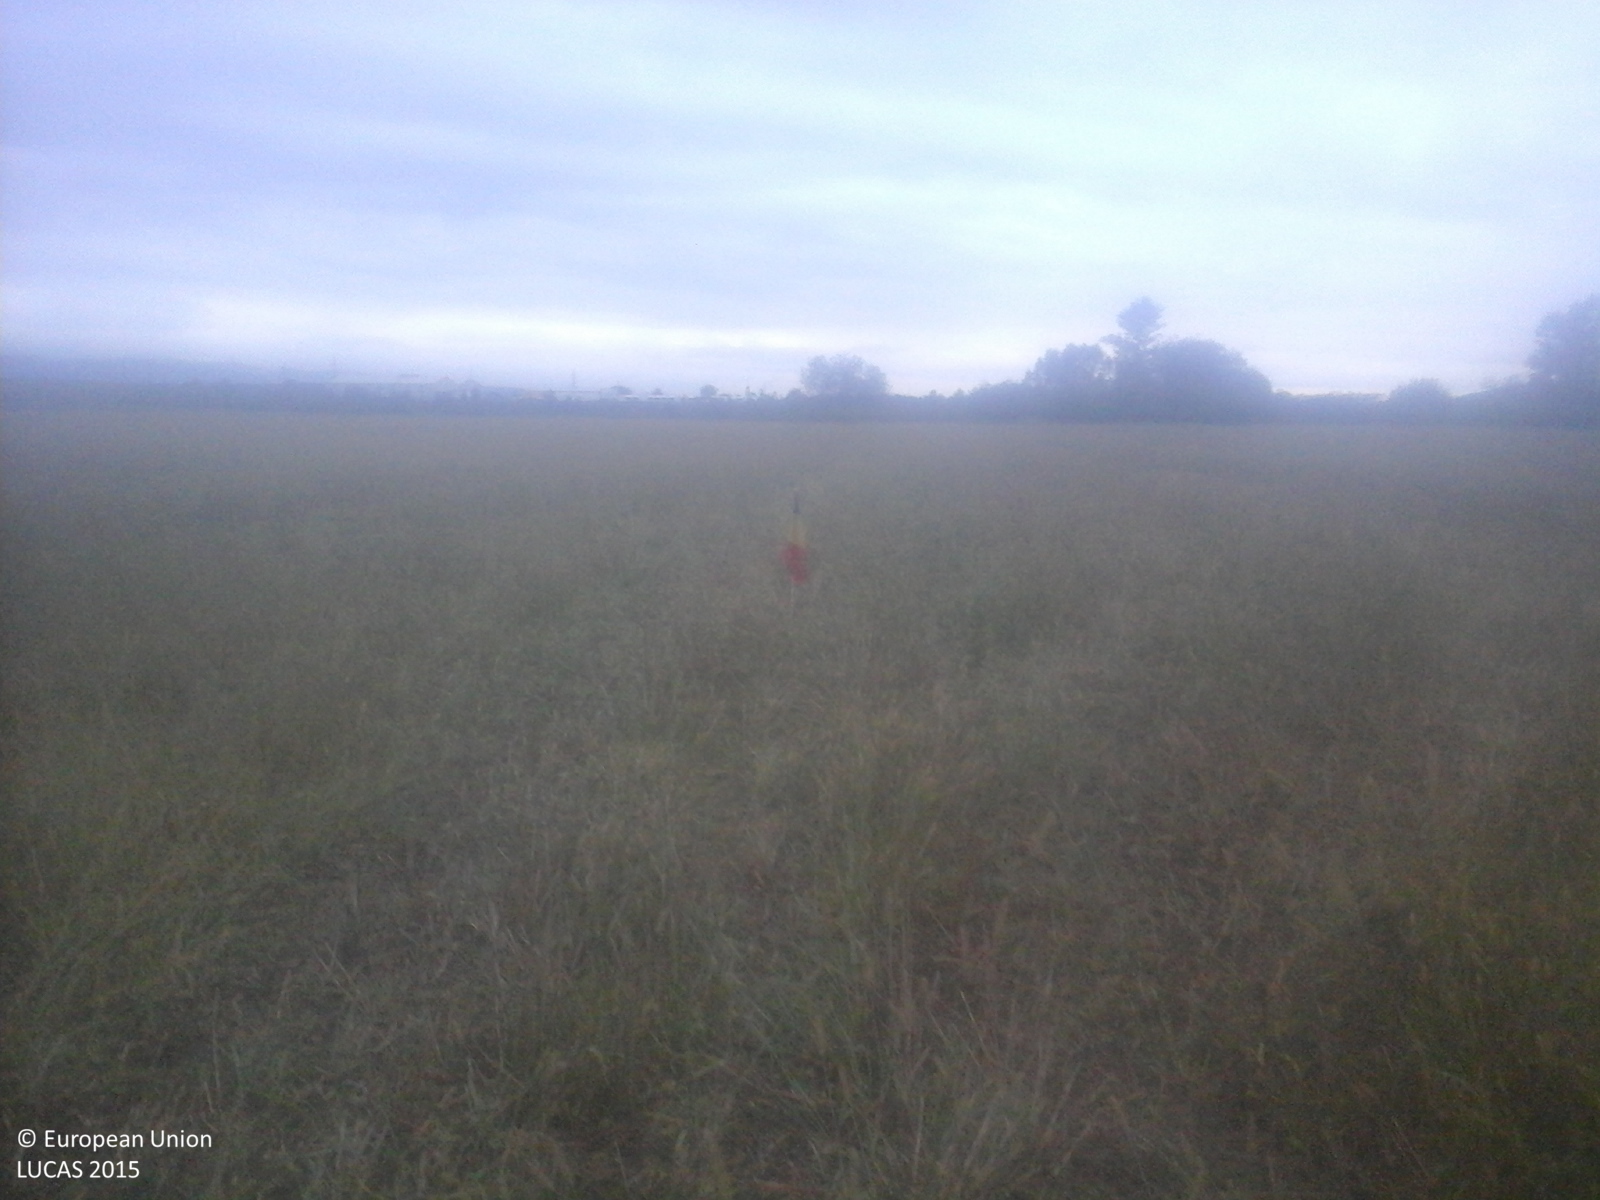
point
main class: Grassland
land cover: Spontaneously vegetated surfaces
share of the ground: > 75 %
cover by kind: herbaceous plants 100 %
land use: Fallow land
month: September
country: RO
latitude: 46.0185
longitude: 23.5111
